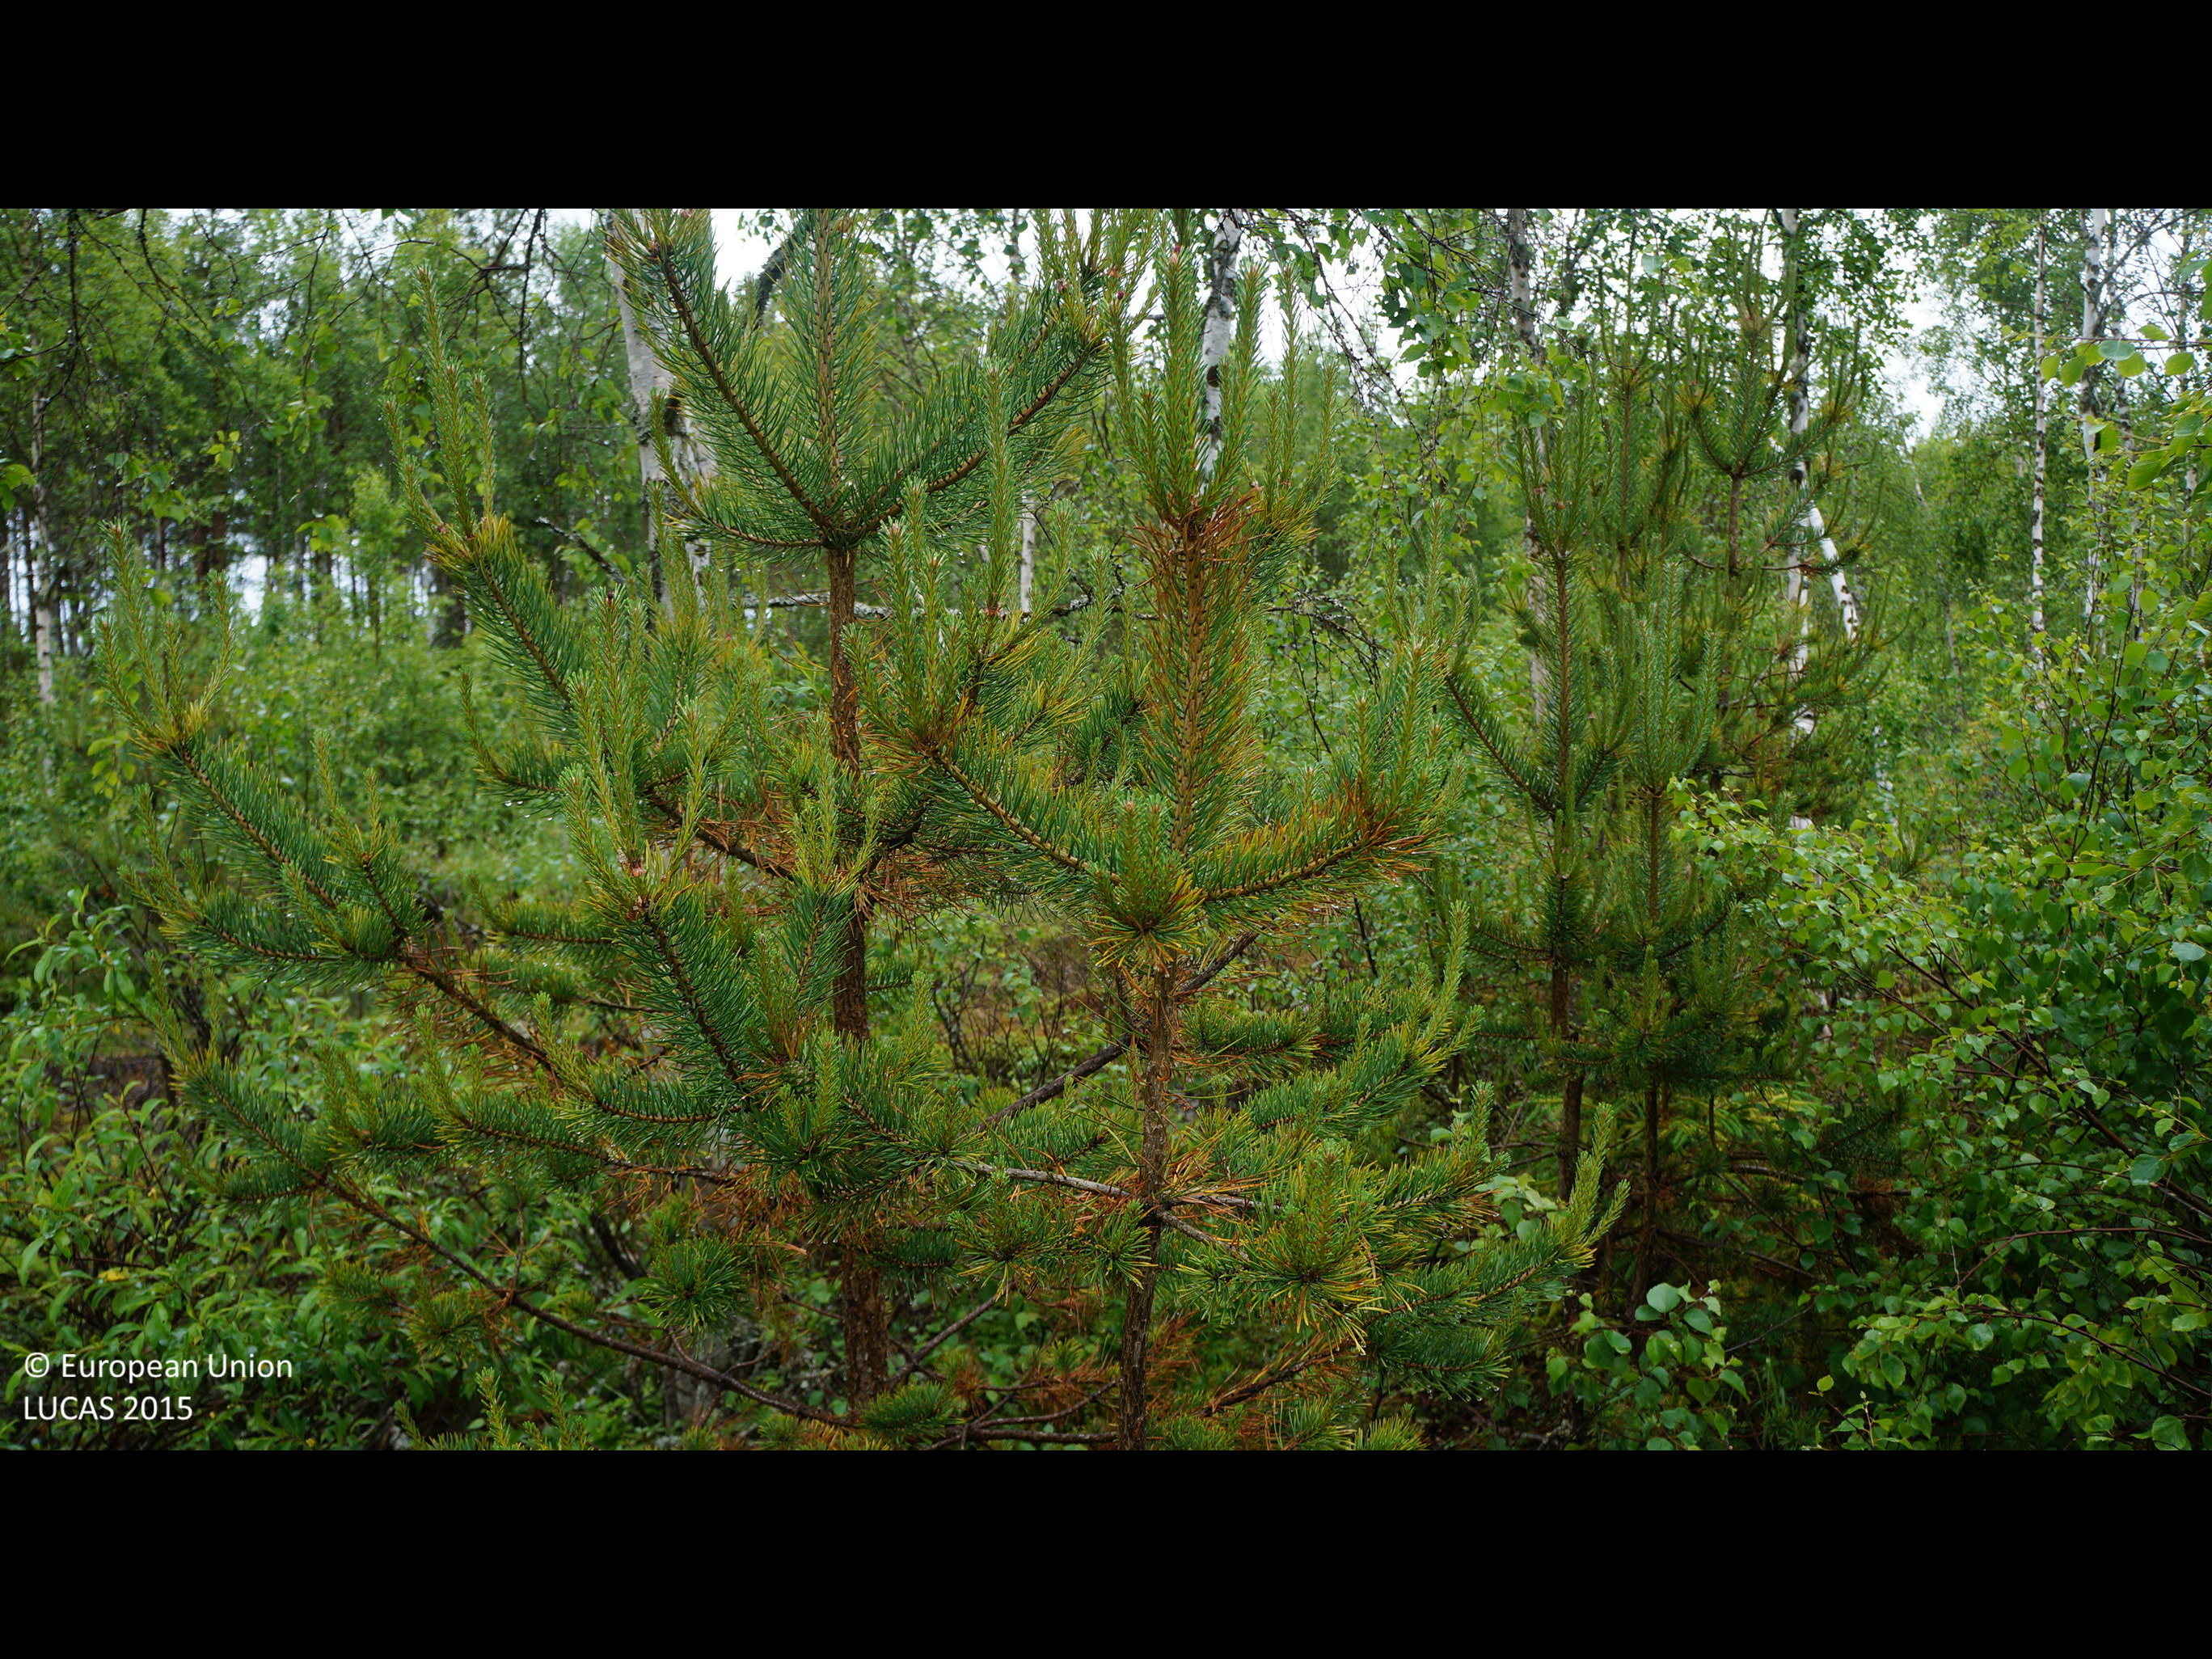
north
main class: Woodland
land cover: Broadleaved woodland
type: boreal forest
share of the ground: > 75 %
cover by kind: broadleaved forest trees 70 %, shrubs 15 %, coniferous forest trees 10 %, lichens and mosses 5 %
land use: Forestry
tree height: > 5 m
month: June
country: FI
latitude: 64.3110
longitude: 24.5663
